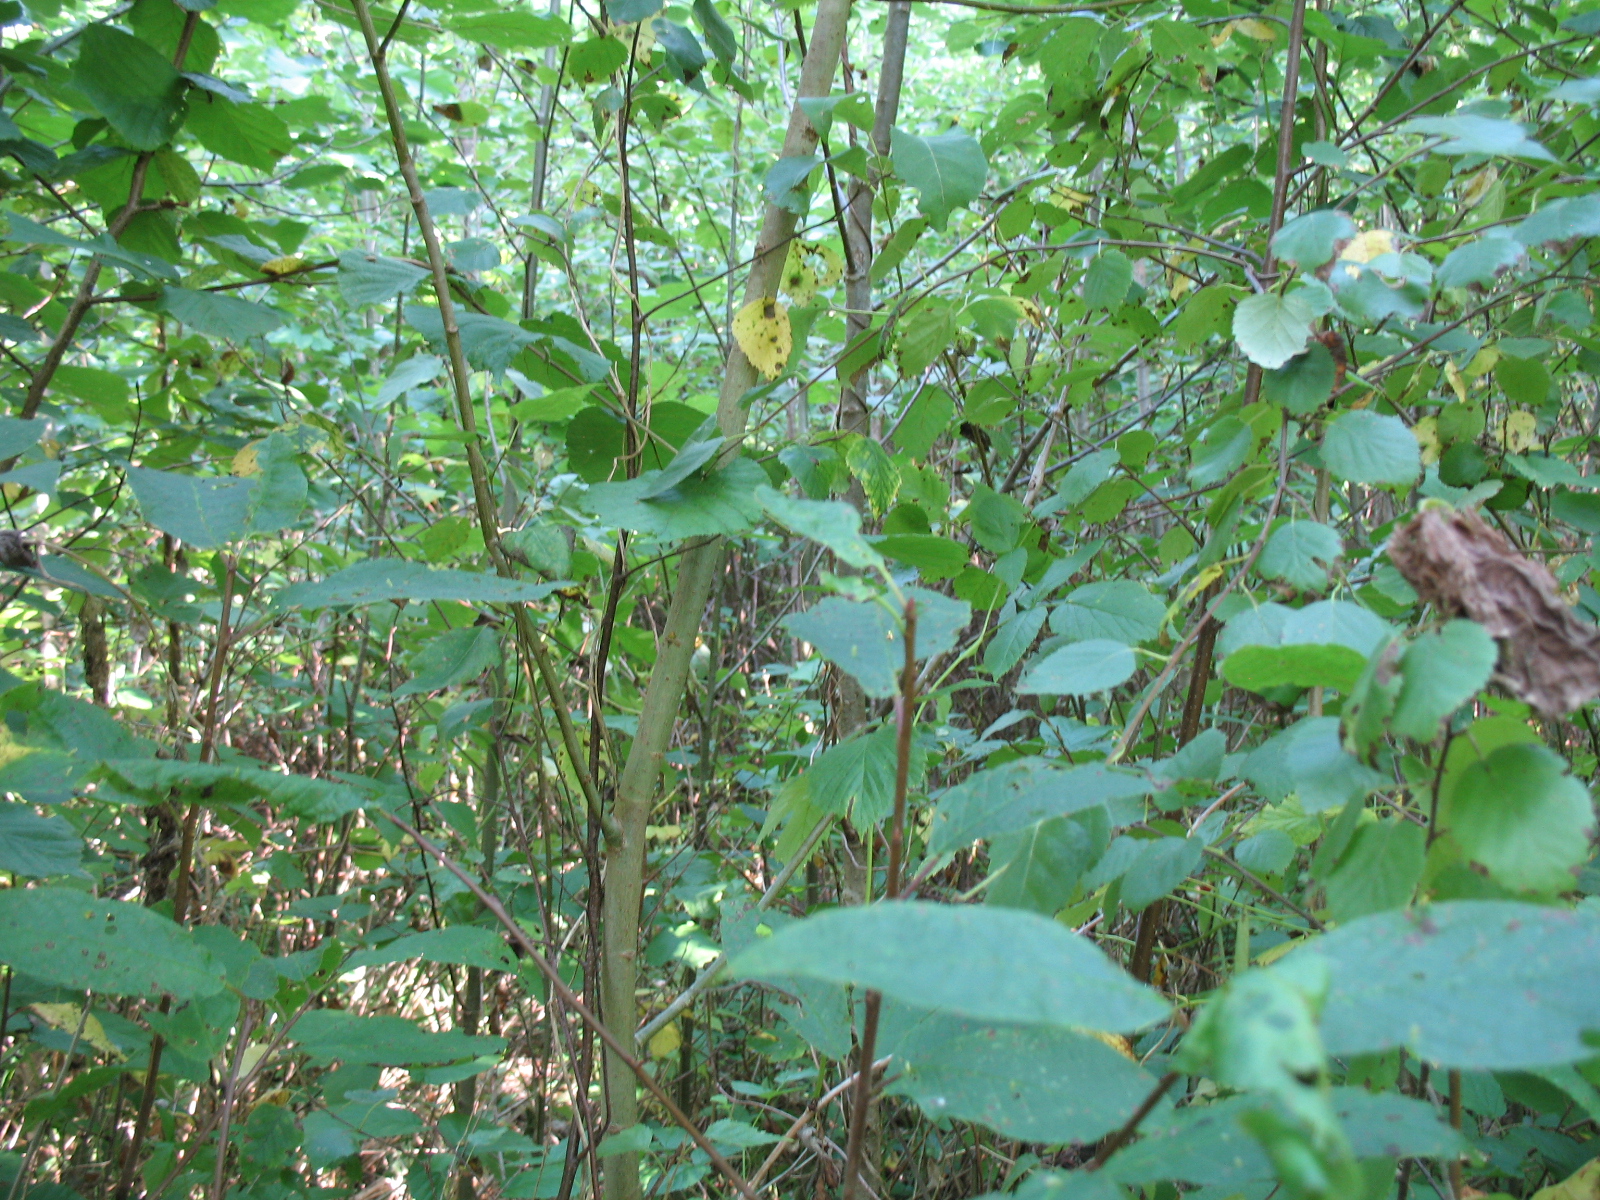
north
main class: Woodland
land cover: Spruce dominated mixed woodland
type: hemiboreal forest and nemoral coniferous forest and mixed broadleaved-coniferous forest
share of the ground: > 75 %
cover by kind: broadleaved forest trees 65 %, coniferous forest trees 30 %, herbaceous plants 5 %
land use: Forestry
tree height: > 5 m
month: August
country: LV
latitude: 56.2020
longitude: 25.4163
